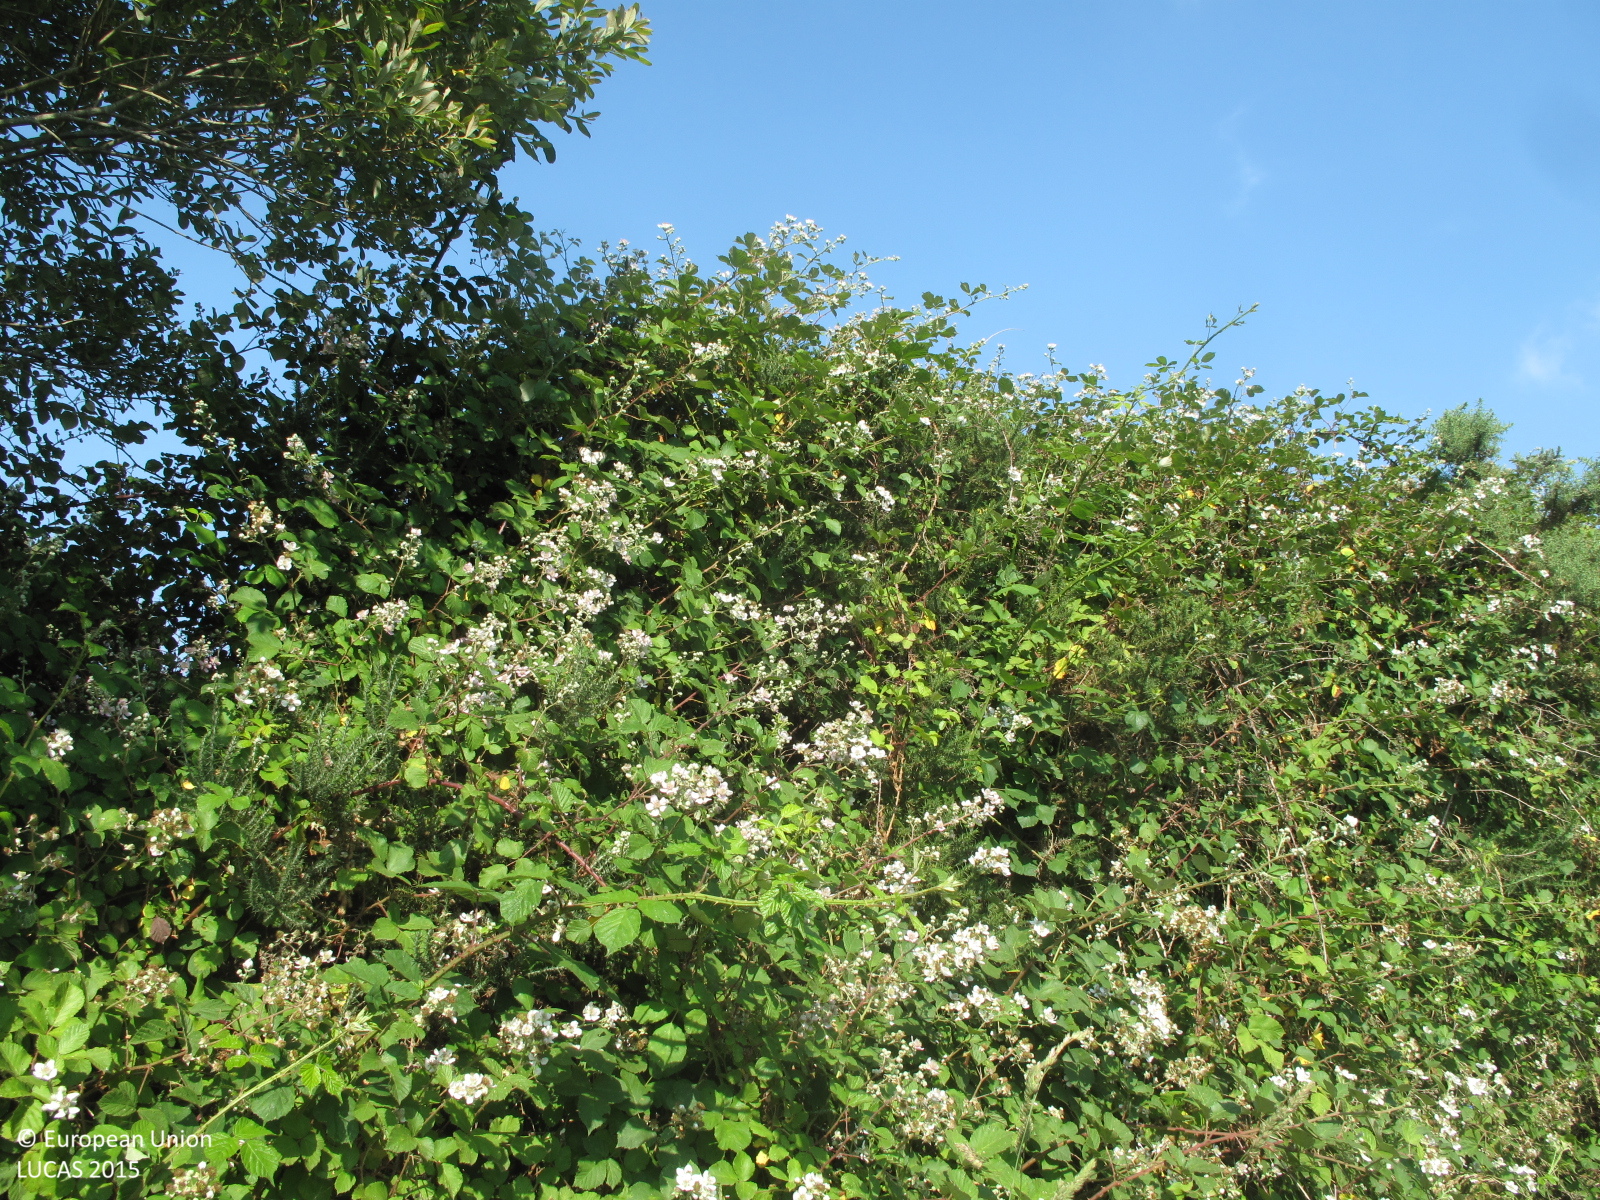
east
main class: Woodland
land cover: Broadleaved woodland
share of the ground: 25 - 50 %
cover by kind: broadleaved forest trees 40 %, shrubs 40 %, herbaceous plants 20 %
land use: Forestry
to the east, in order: Broadleaved woodland; Grassland without tree/shrub cover; Groves; Grassland without tree/shrub cover; Groves; Shrubland with sparse tree cover; Tracks; Shruby margins; Groves; Grassland without tree/shrub cover
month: June
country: ES
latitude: 43.0111
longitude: -7.9395
